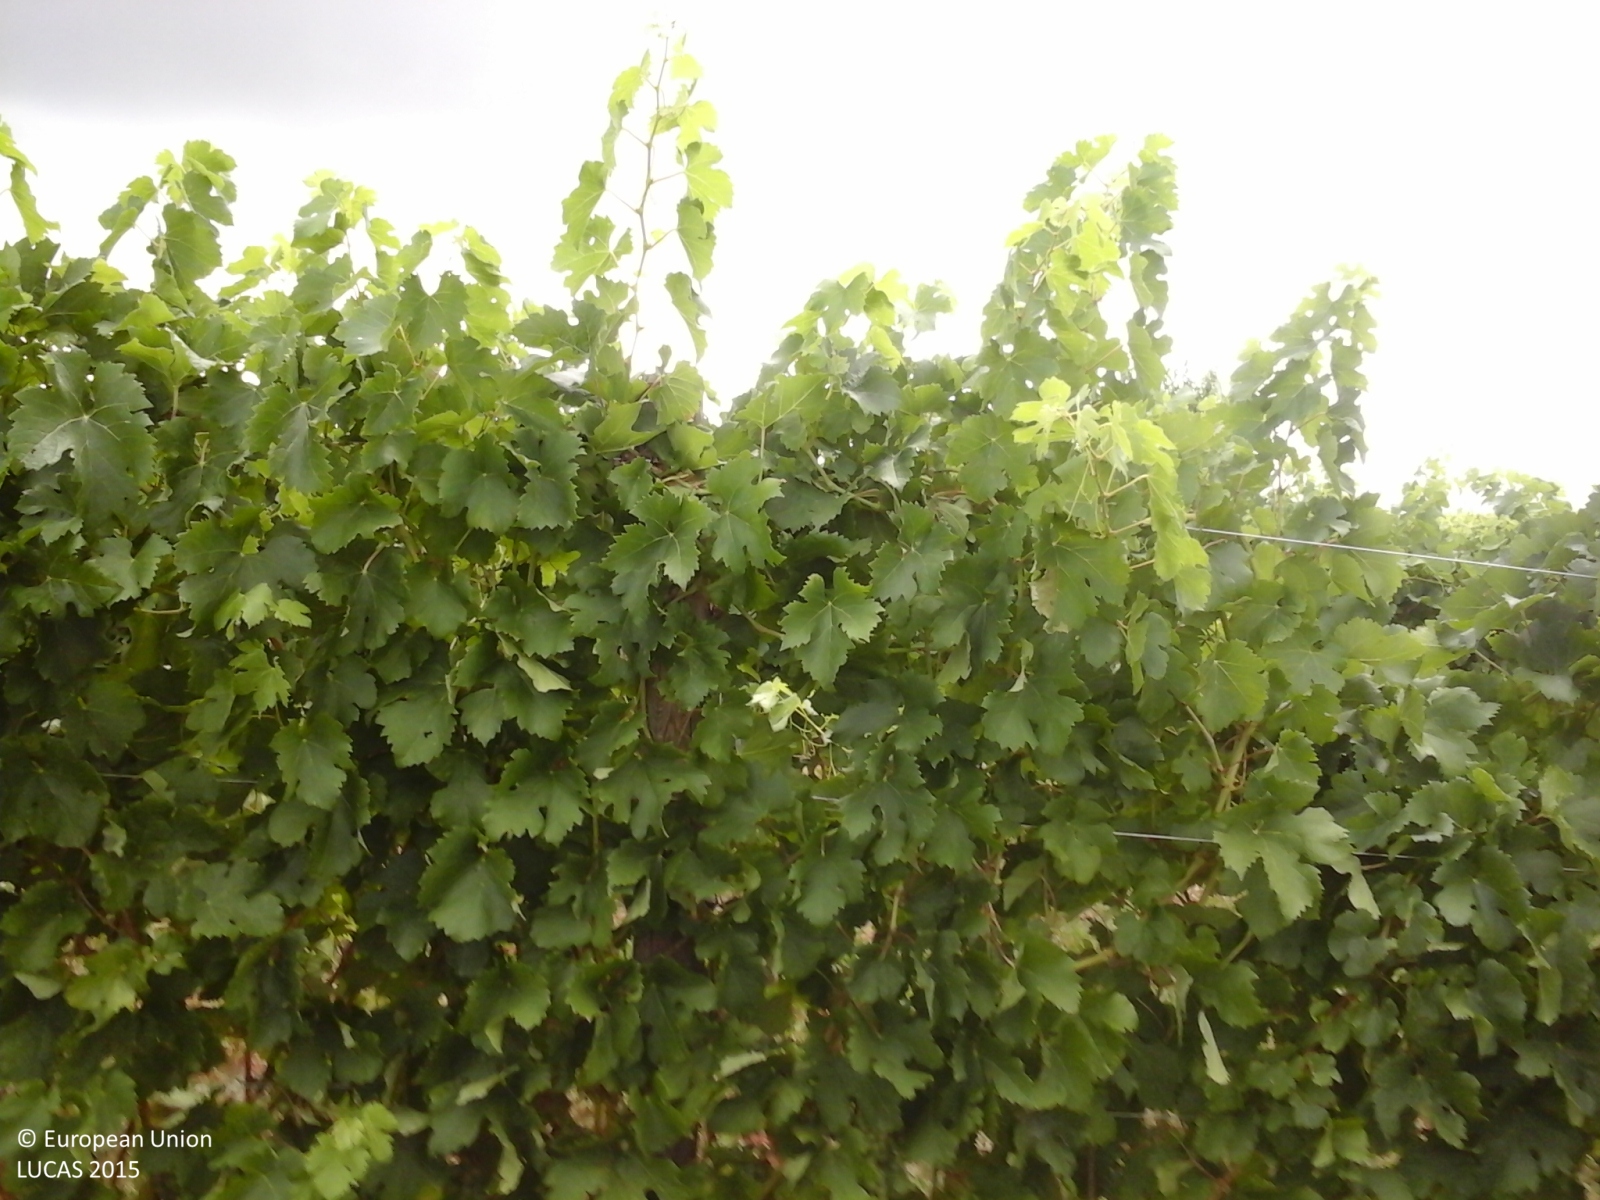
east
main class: Cropland
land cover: Vineyards
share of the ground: 50 - 75 %
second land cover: Spontaneously vegetated surfaces
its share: 50 - 75 %
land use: Agriculture (excluding fallow land and kitchen gardens)
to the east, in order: Vineyards; Spontaneously vegetated surfaces; Grassland without tree/shrub cover; Paved roads, cycling and walking lanes; Vineyards; Grassland without tree/shrub cover
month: July
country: IT
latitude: 43.2718
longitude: 13.2074
